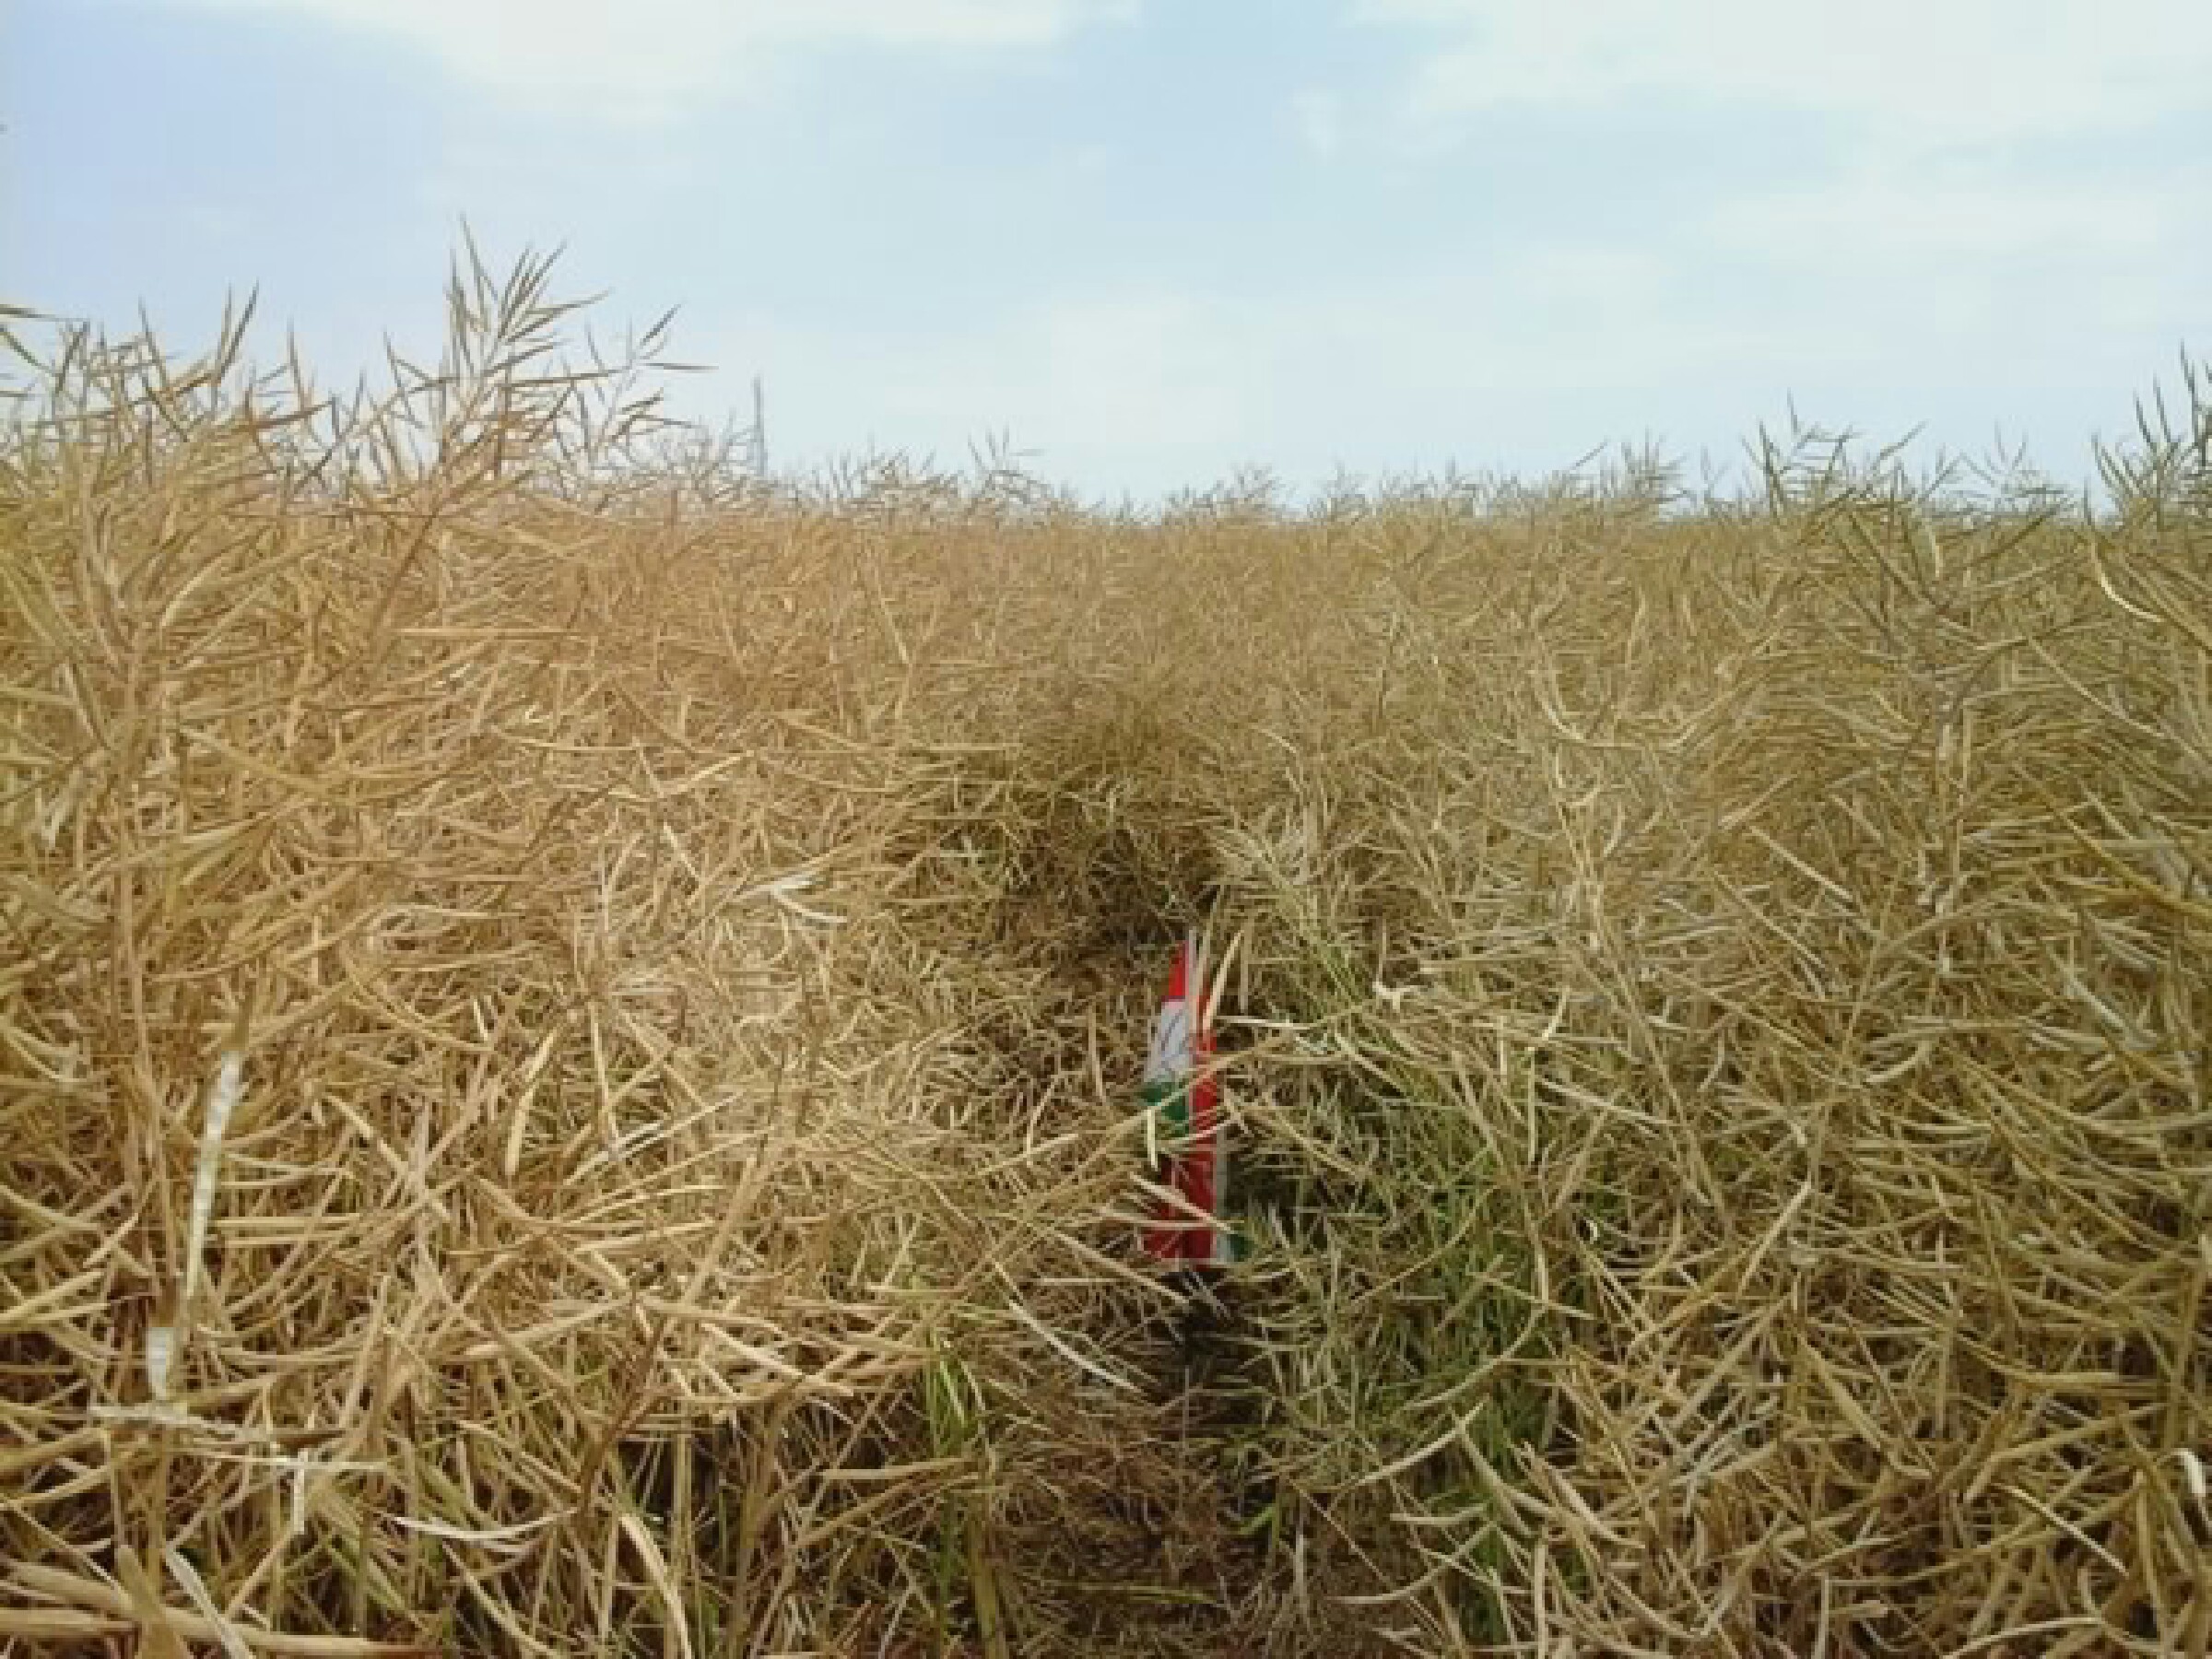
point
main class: Cropland
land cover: Rape and turnip rape
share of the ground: > 75 %
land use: Agriculture (excluding fallow land and kitchen gardens)
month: July
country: HU
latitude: 47.8493
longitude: 19.2821
